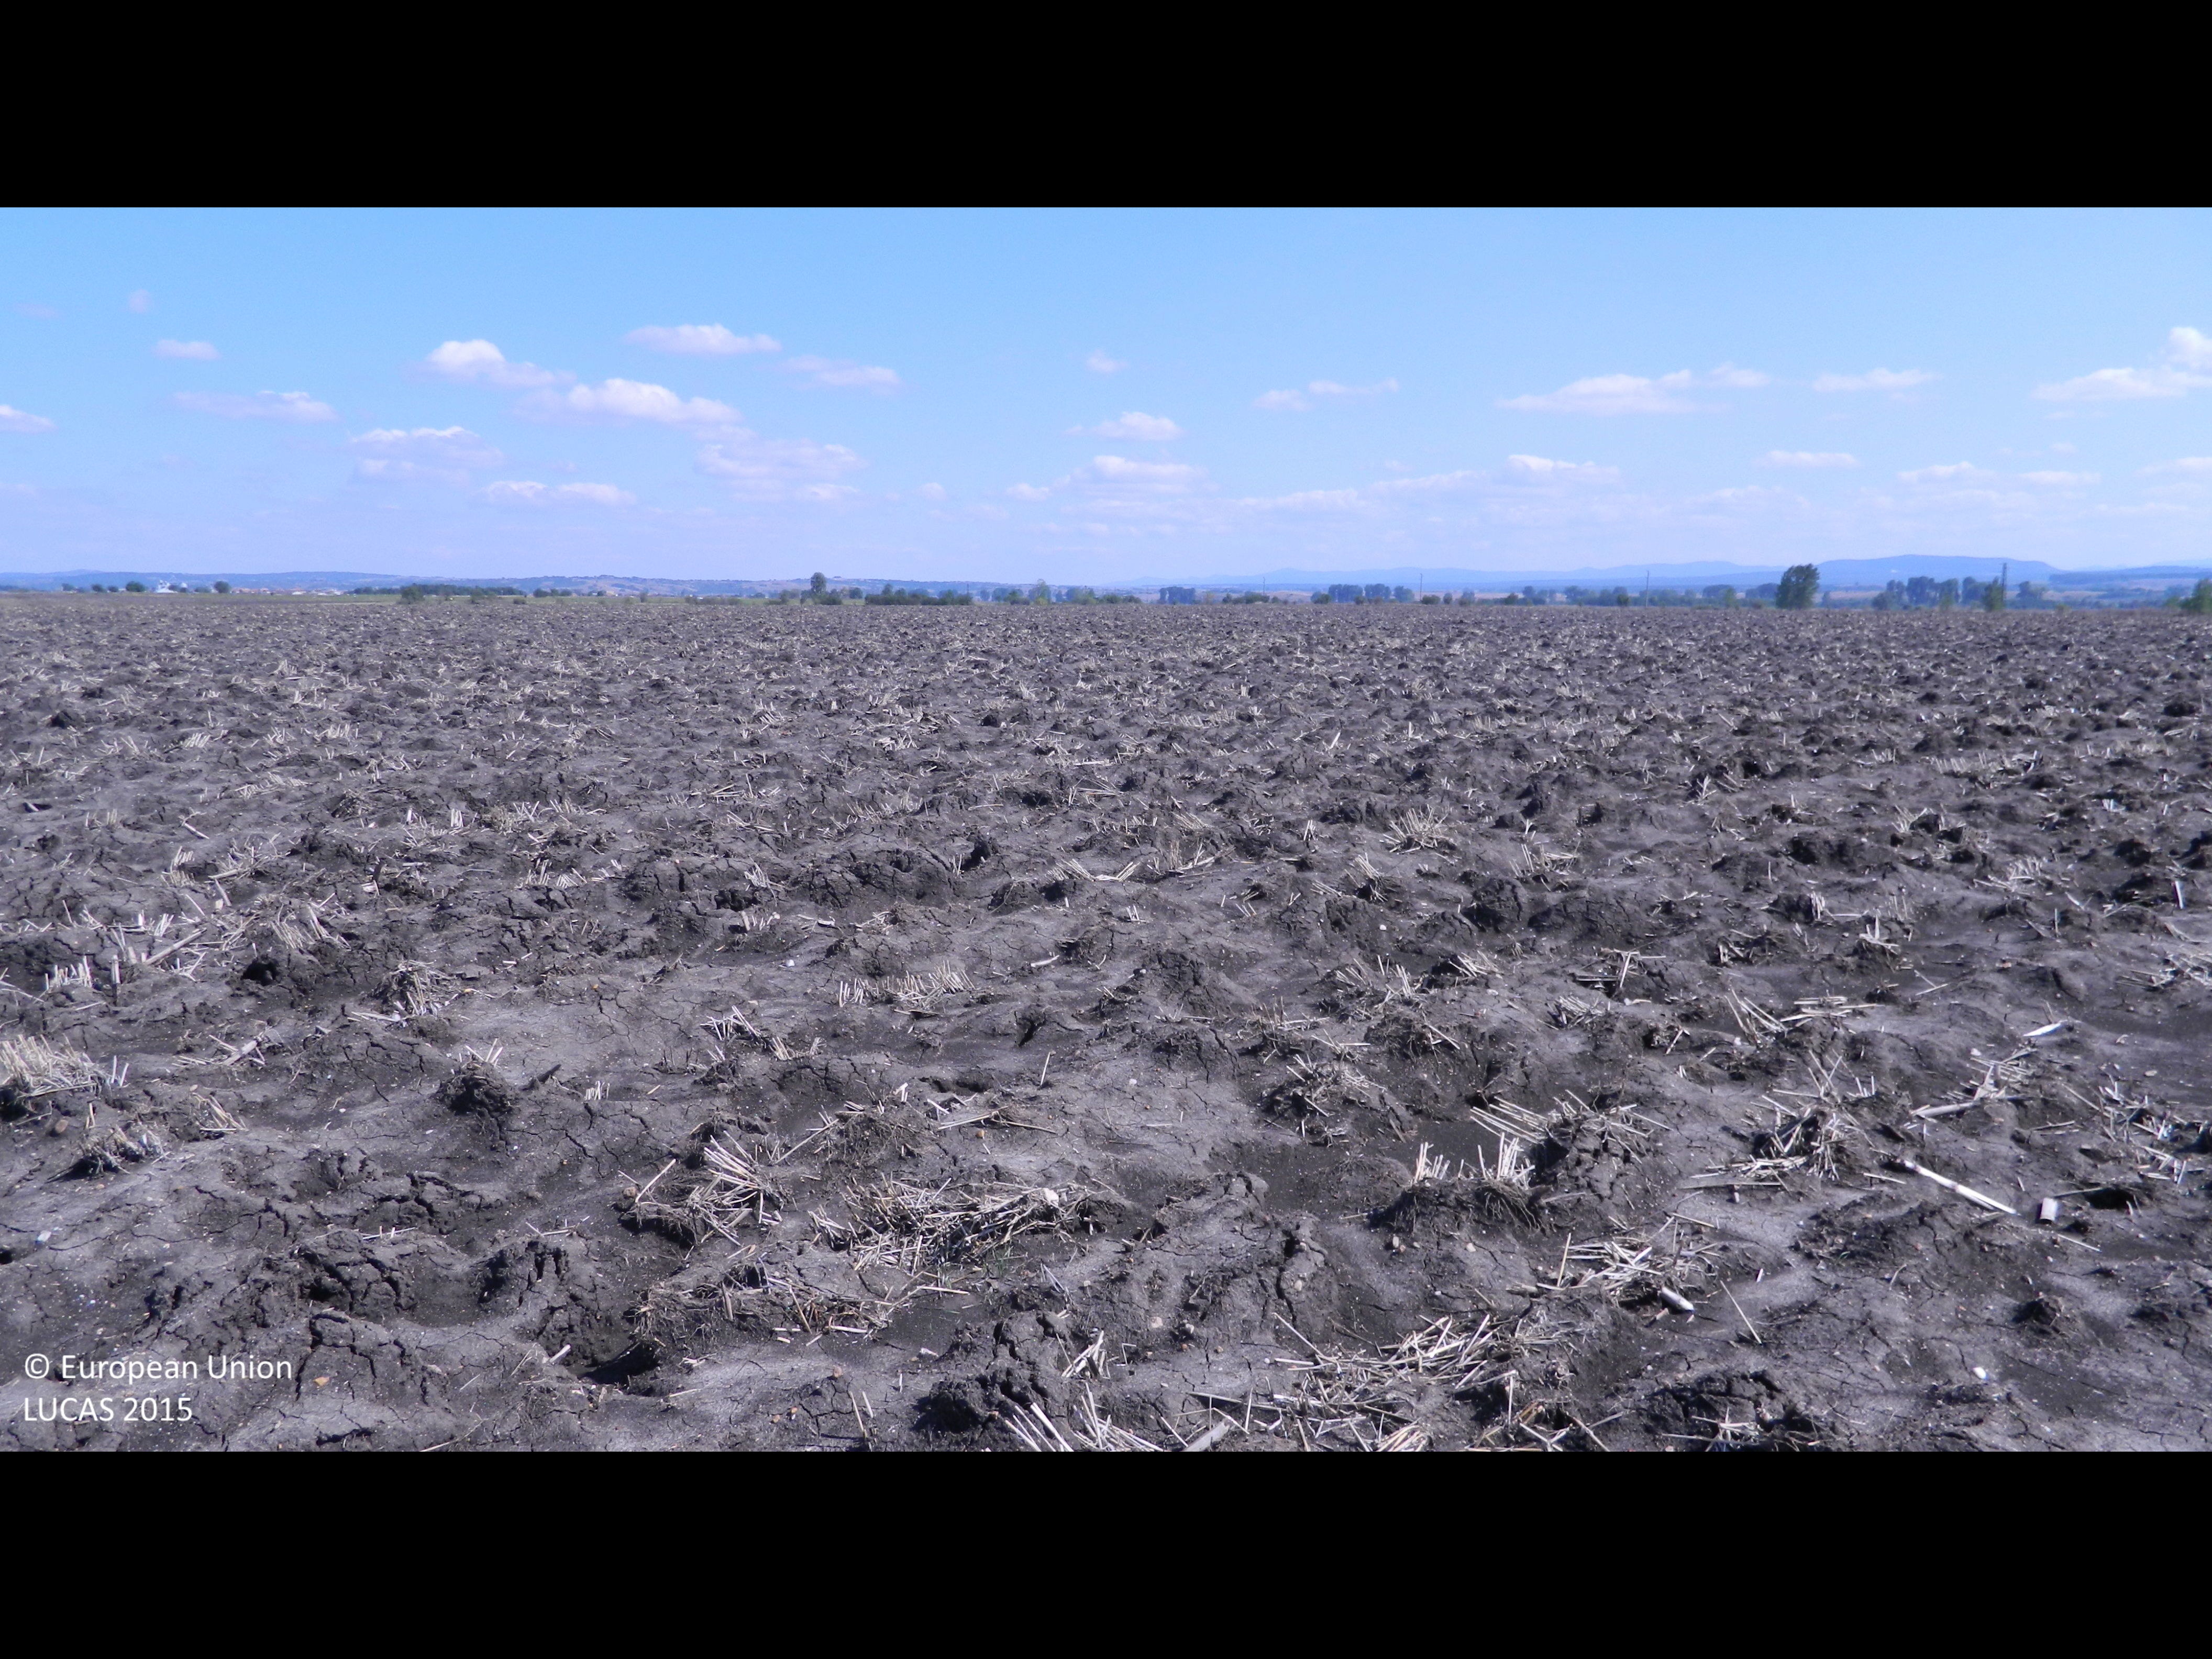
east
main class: Cropland
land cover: Barley
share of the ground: < 10 %
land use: Agriculture (excluding fallow land and kitchen gardens)
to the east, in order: Barley
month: September
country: BG
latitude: 41.8602
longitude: 25.5920
